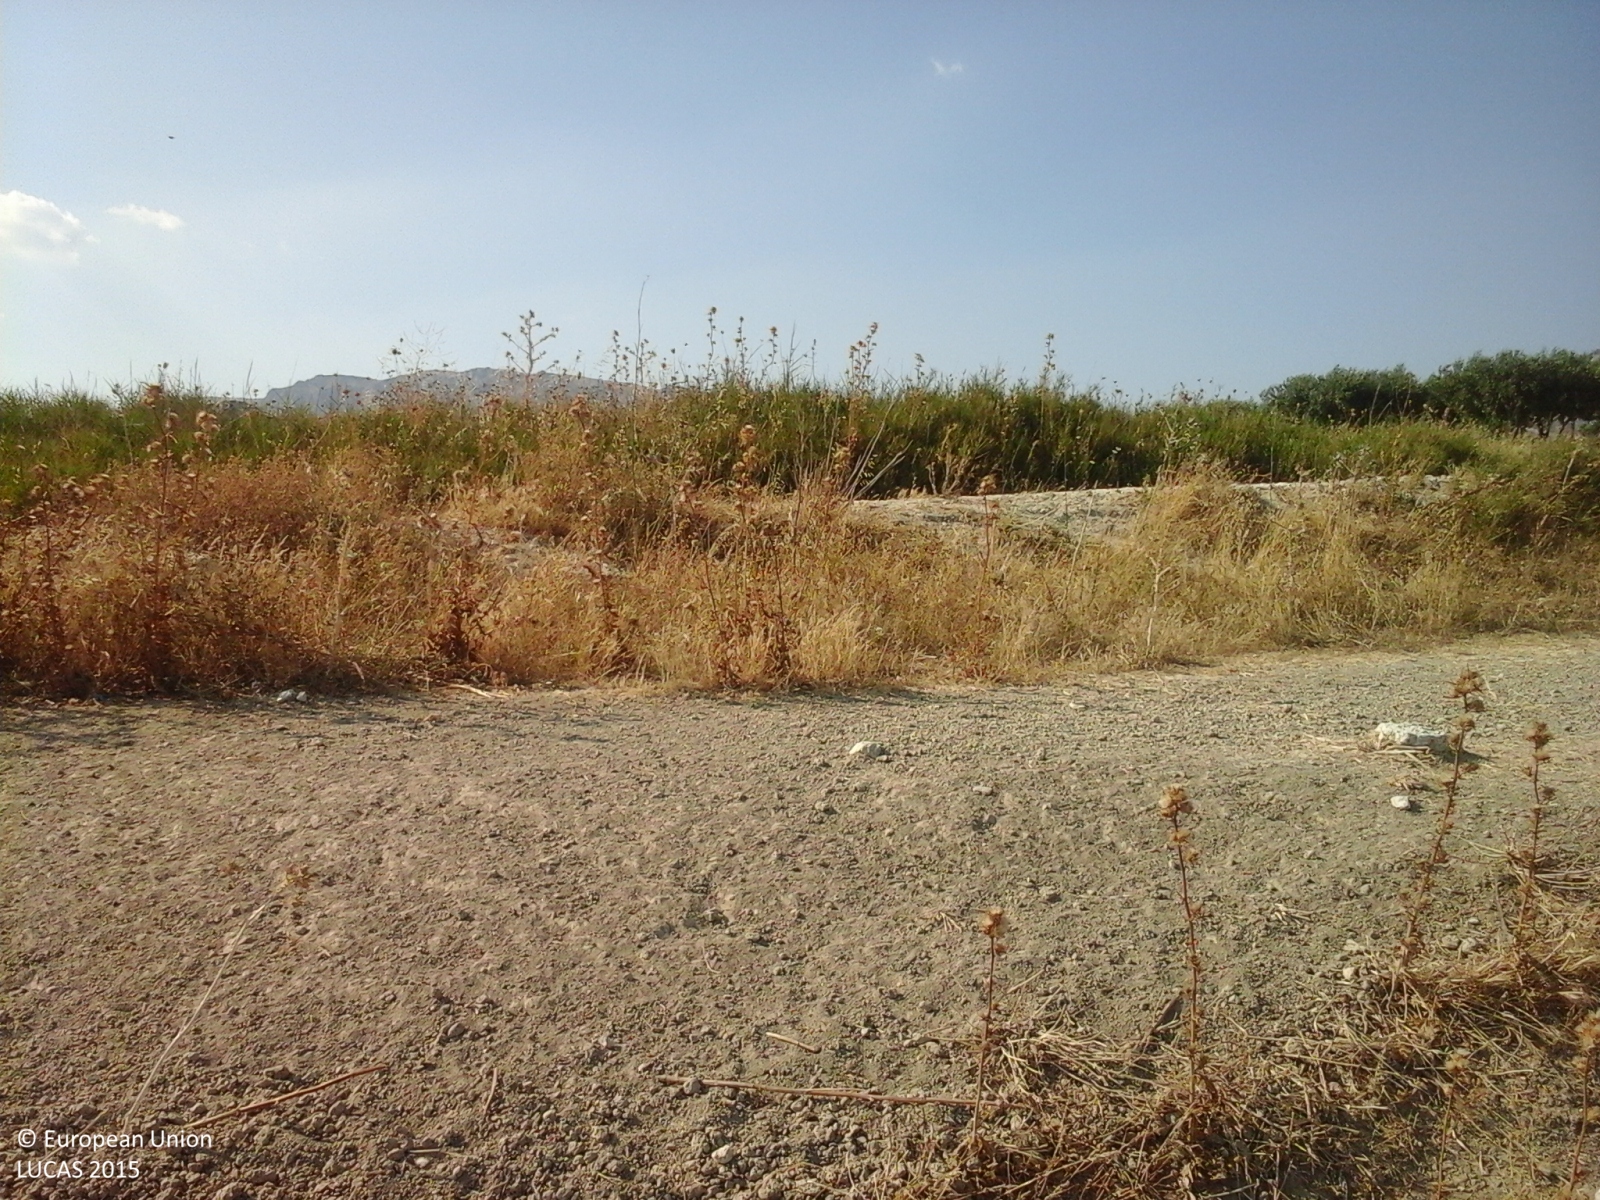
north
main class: Grassland
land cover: Grassland without tree/shrub cover
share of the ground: > 75 %
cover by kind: herbaceous plants 100 %
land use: Agriculture (excluding fallow land and kitchen gardens)
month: July
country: IT
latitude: 37.5309
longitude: 13.1782
